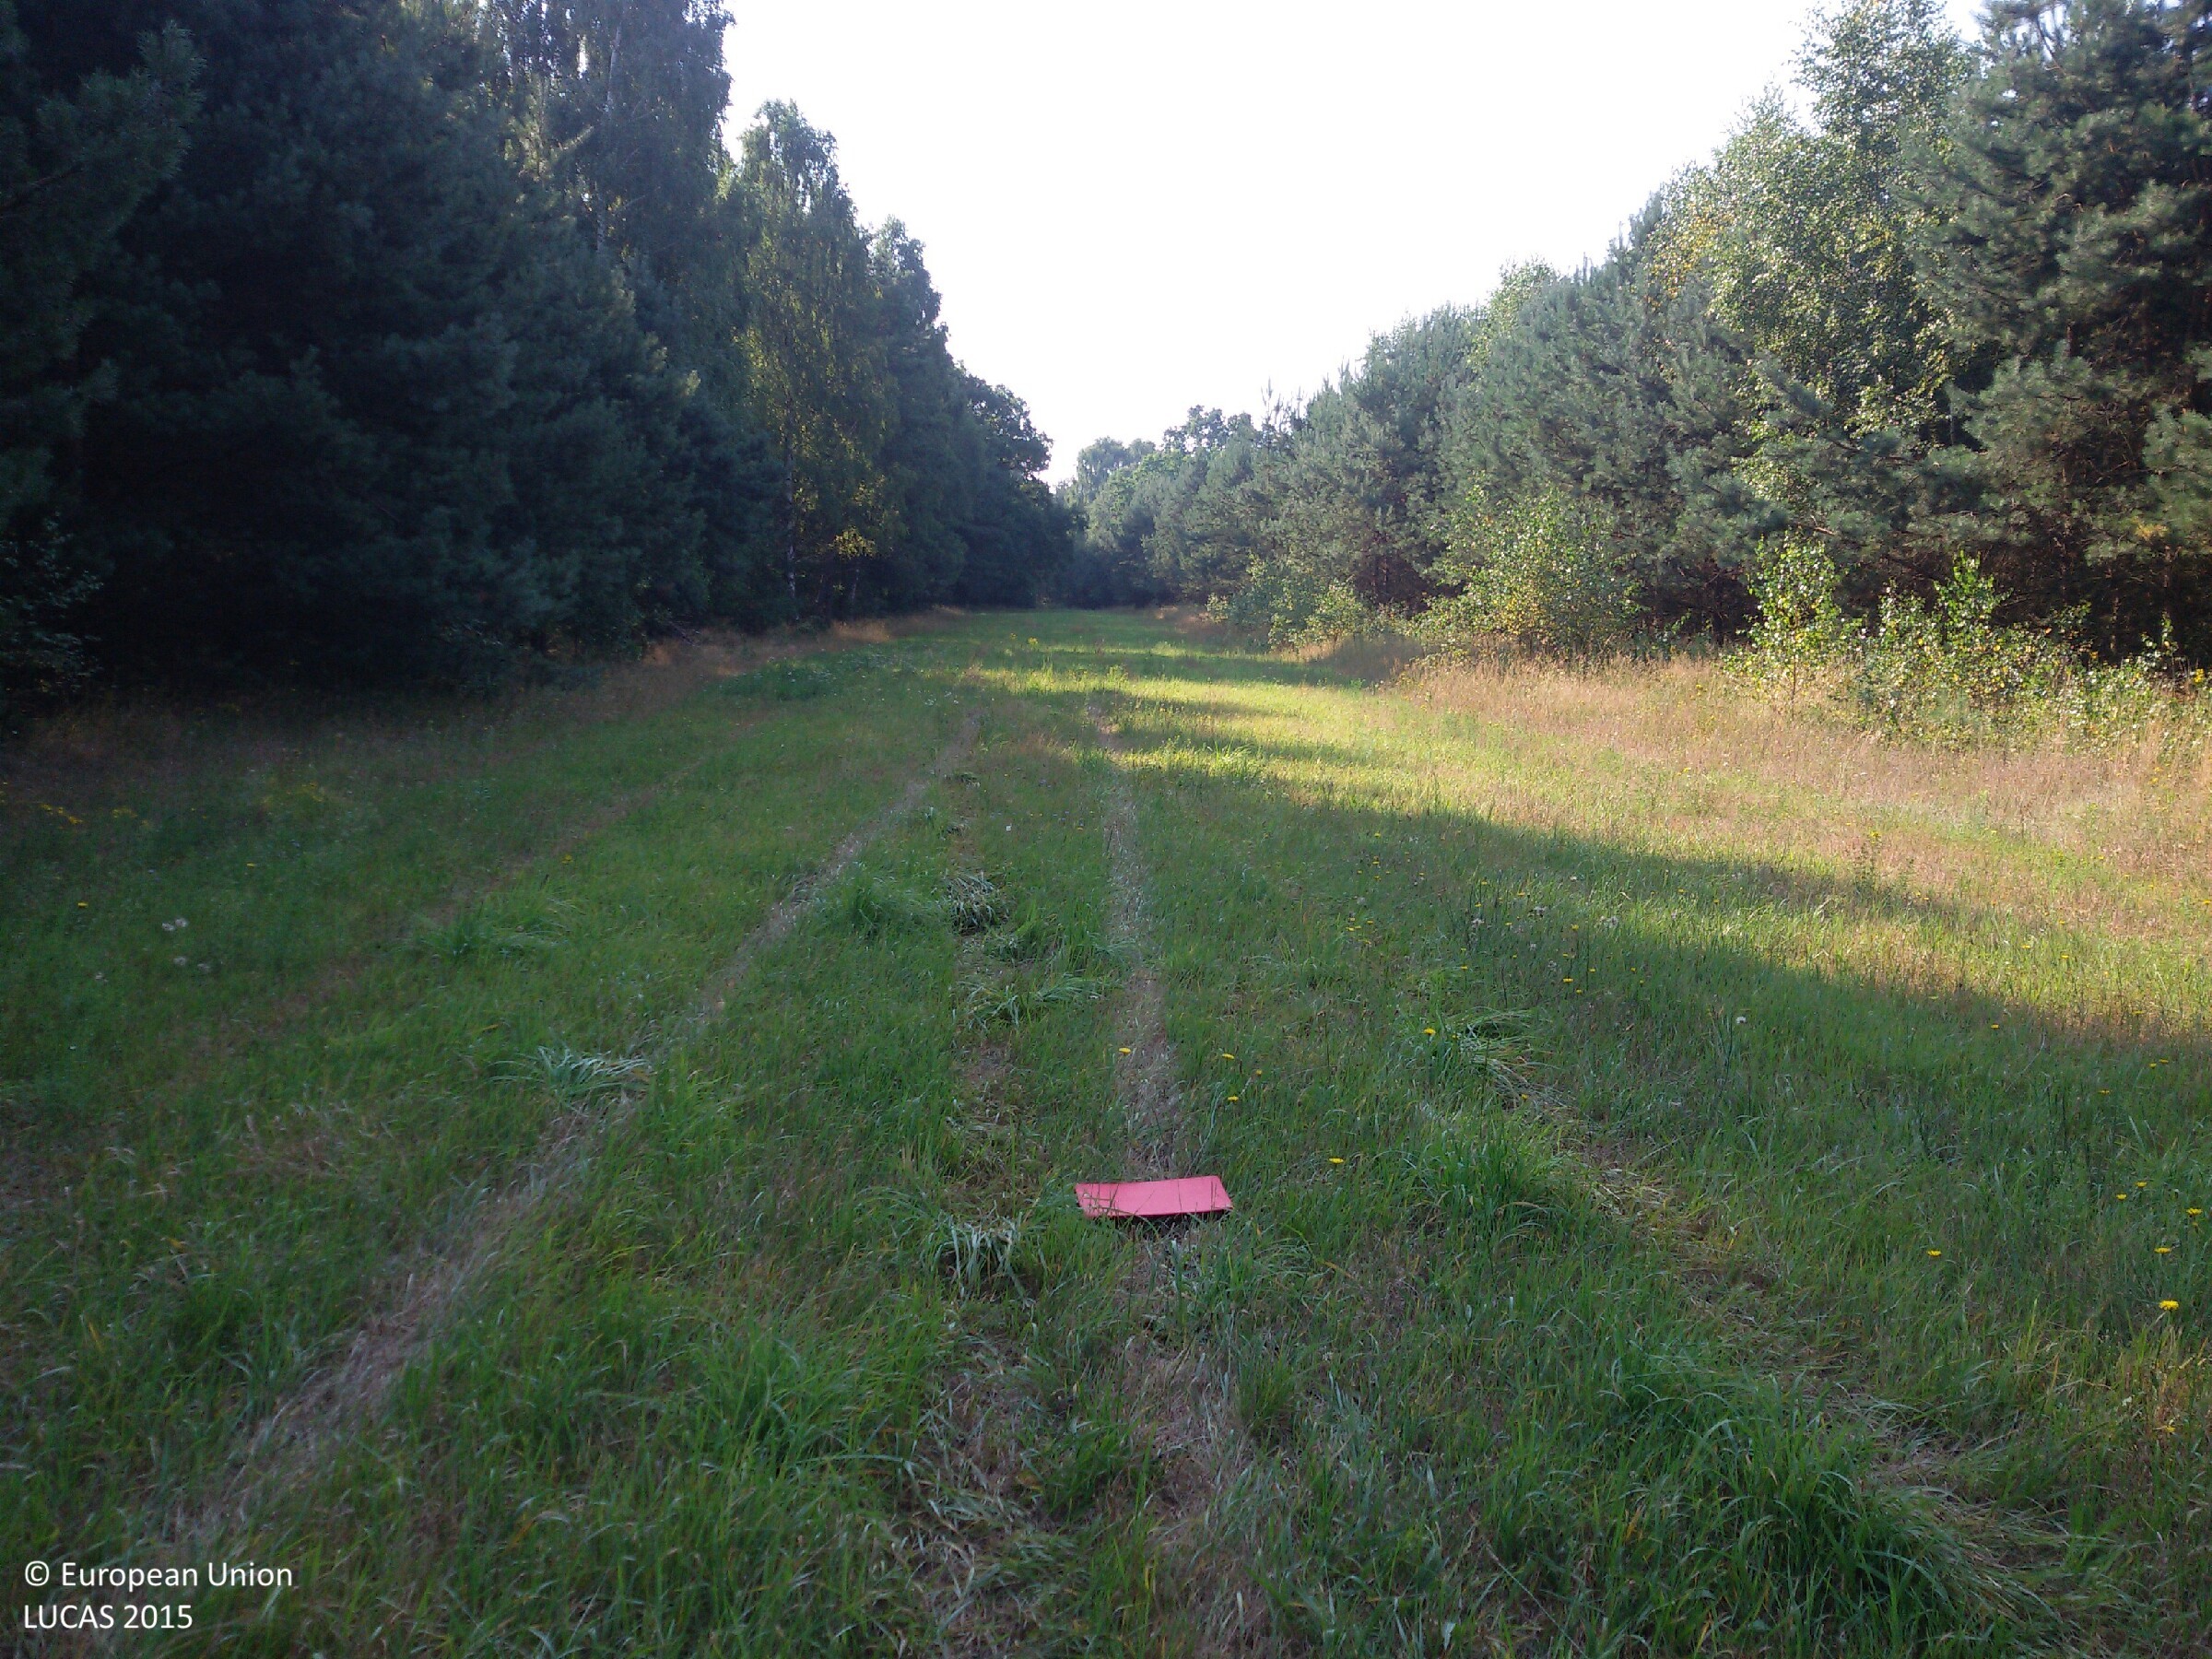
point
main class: Grassland
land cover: Grassland without tree/shrub cover
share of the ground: > 75 %
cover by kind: herbaceous plants 100 %
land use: Agriculture (excluding fallow land and kitchen gardens)
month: August
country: PL
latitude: 52.2188
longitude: 21.8391
